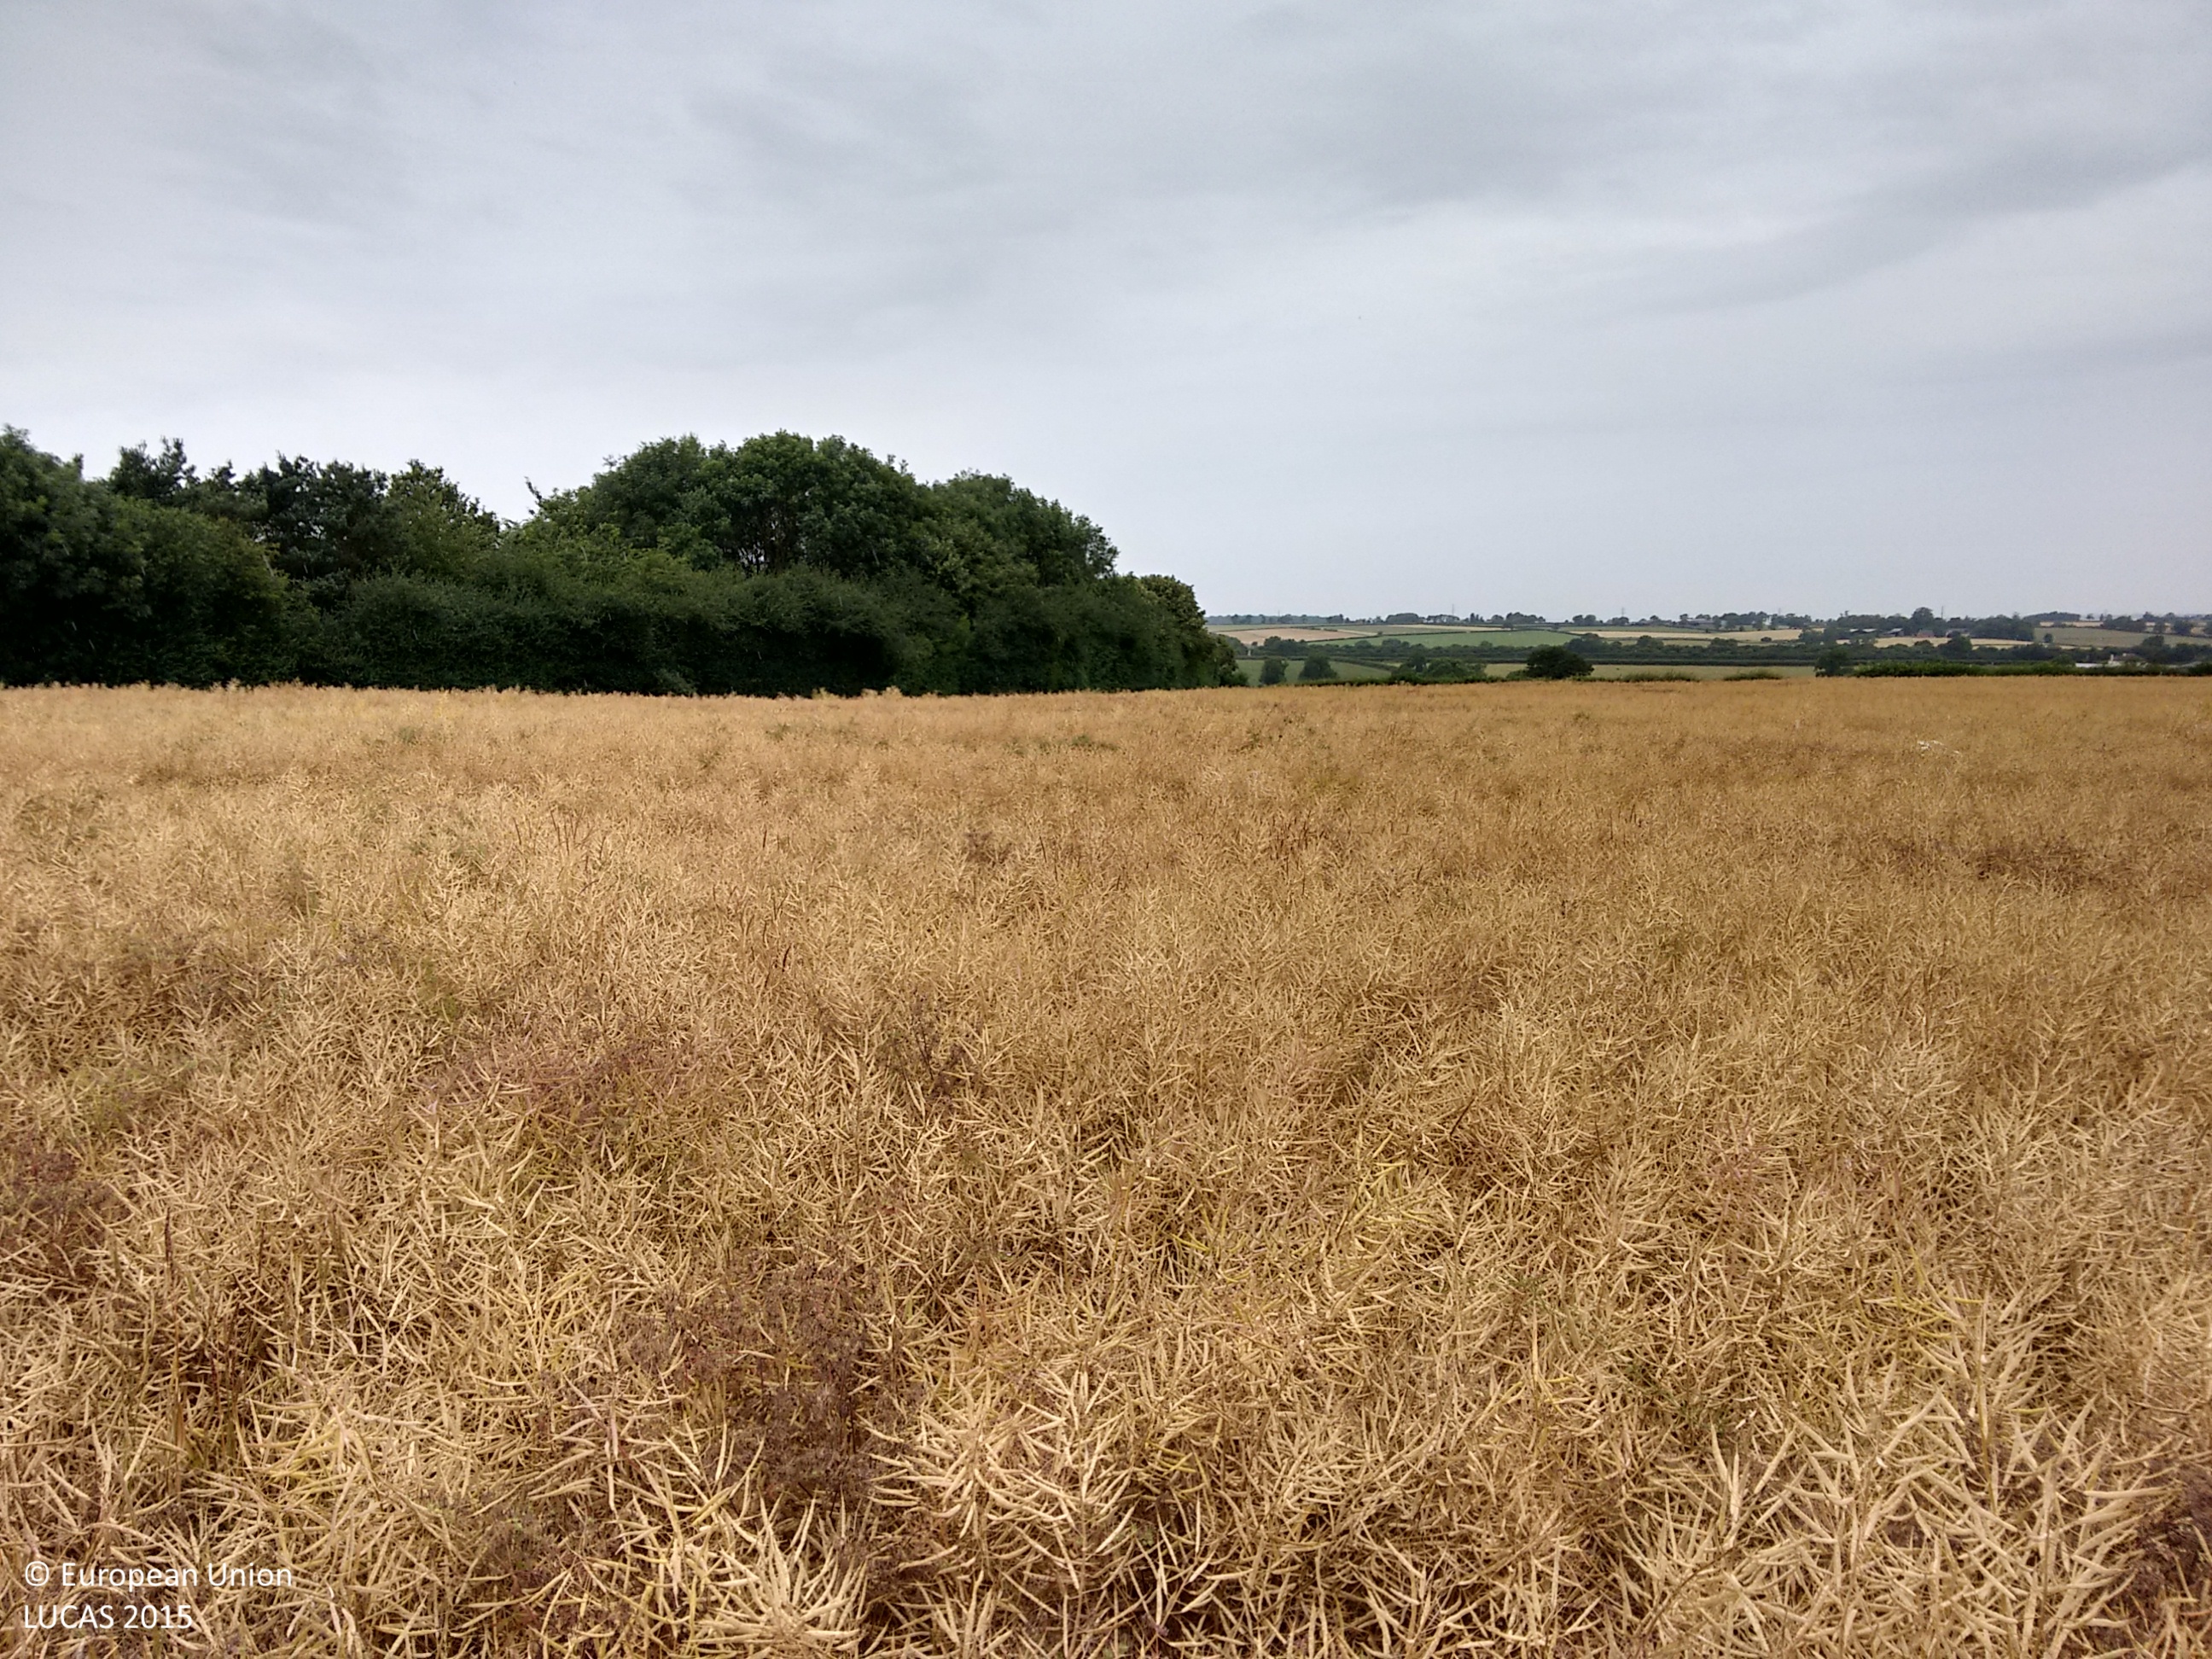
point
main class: Woodland
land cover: Broadleaved woodland
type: mesophytic deciduous forest
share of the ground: > 75 %
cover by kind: broadleaved forest trees 100 %
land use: Semi-natural and natural areas not in use
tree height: > 5 m
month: July
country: GB
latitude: 52.7272
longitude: -0.8965
